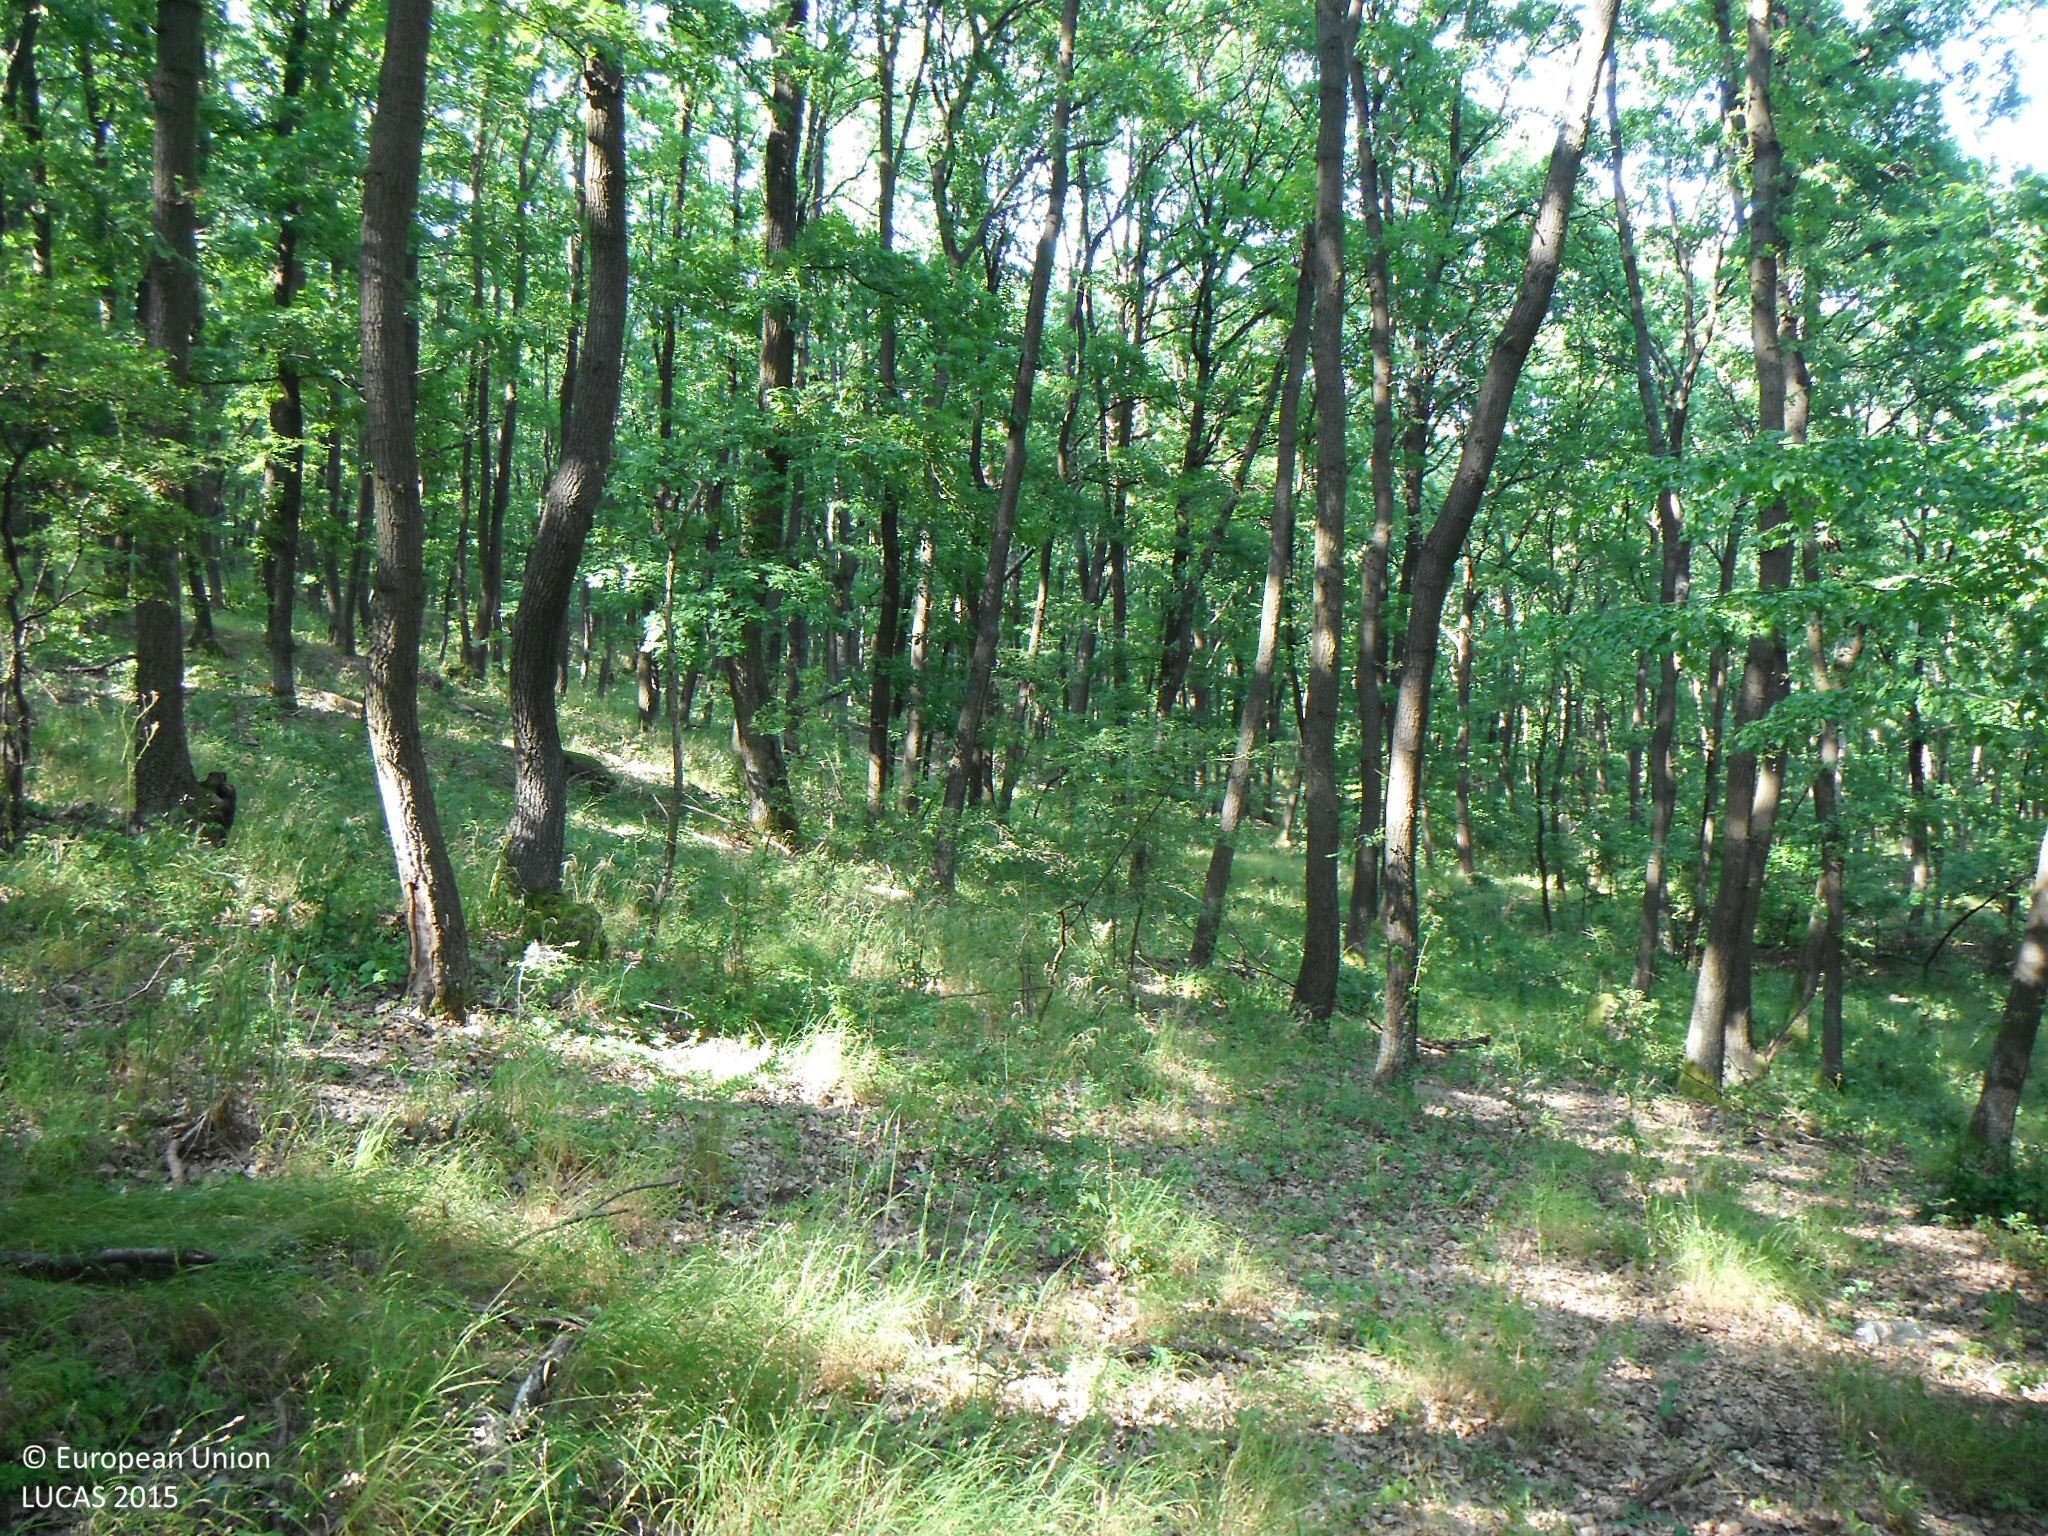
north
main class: Woodland
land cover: Broadleaved woodland
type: acidophilous oak and oak-birch forest
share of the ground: > 75 %
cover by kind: broadleaved forest trees 85 %, herbaceous plants 10 %, shrubs 5 %
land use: Forestry
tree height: > 5 m
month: July
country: SK
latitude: 48.1504
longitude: 19.1477
